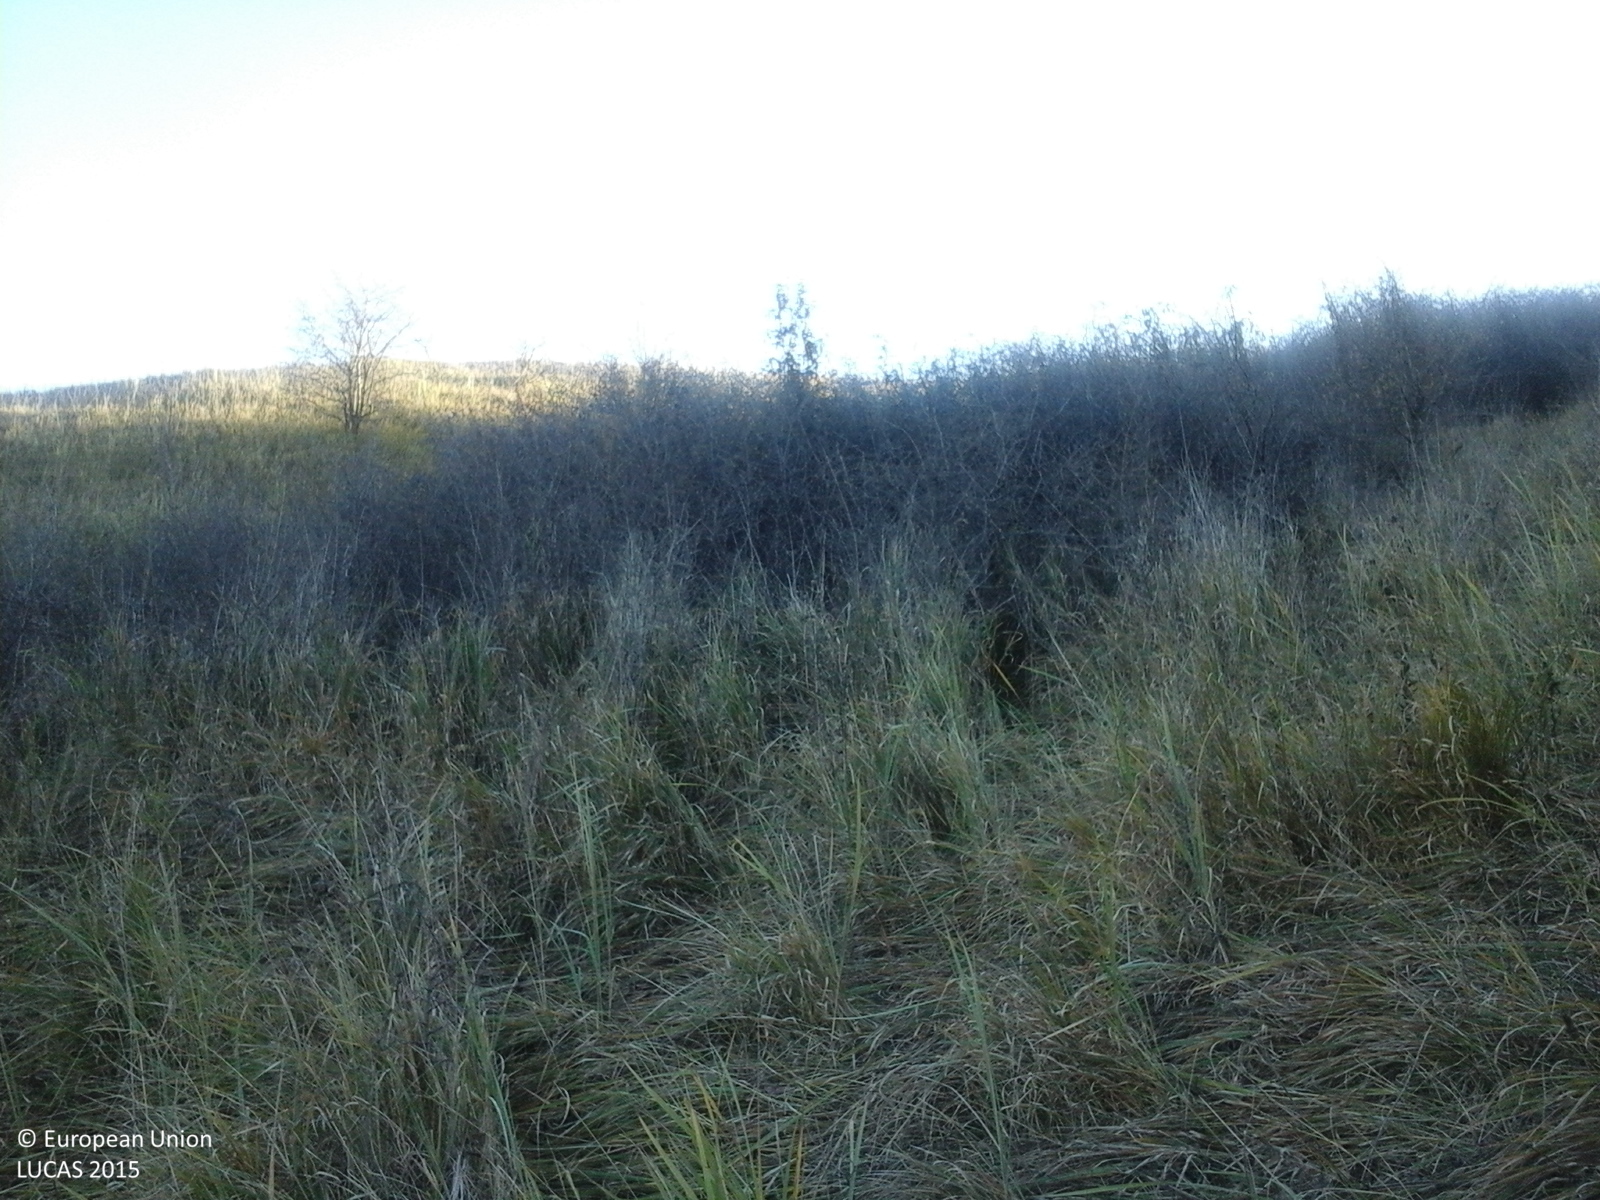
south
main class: Grassland
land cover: Grassland with sparse tree/shrub cover
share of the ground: > 75 %
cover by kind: herbaceous plants 85 %, shrubs 10 %, broadleaved forest trees 5 %
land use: Agriculture (excluding fallow land and kitchen gardens)
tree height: > 5 m
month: October
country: RO
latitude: 45.3203
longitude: 26.7007
